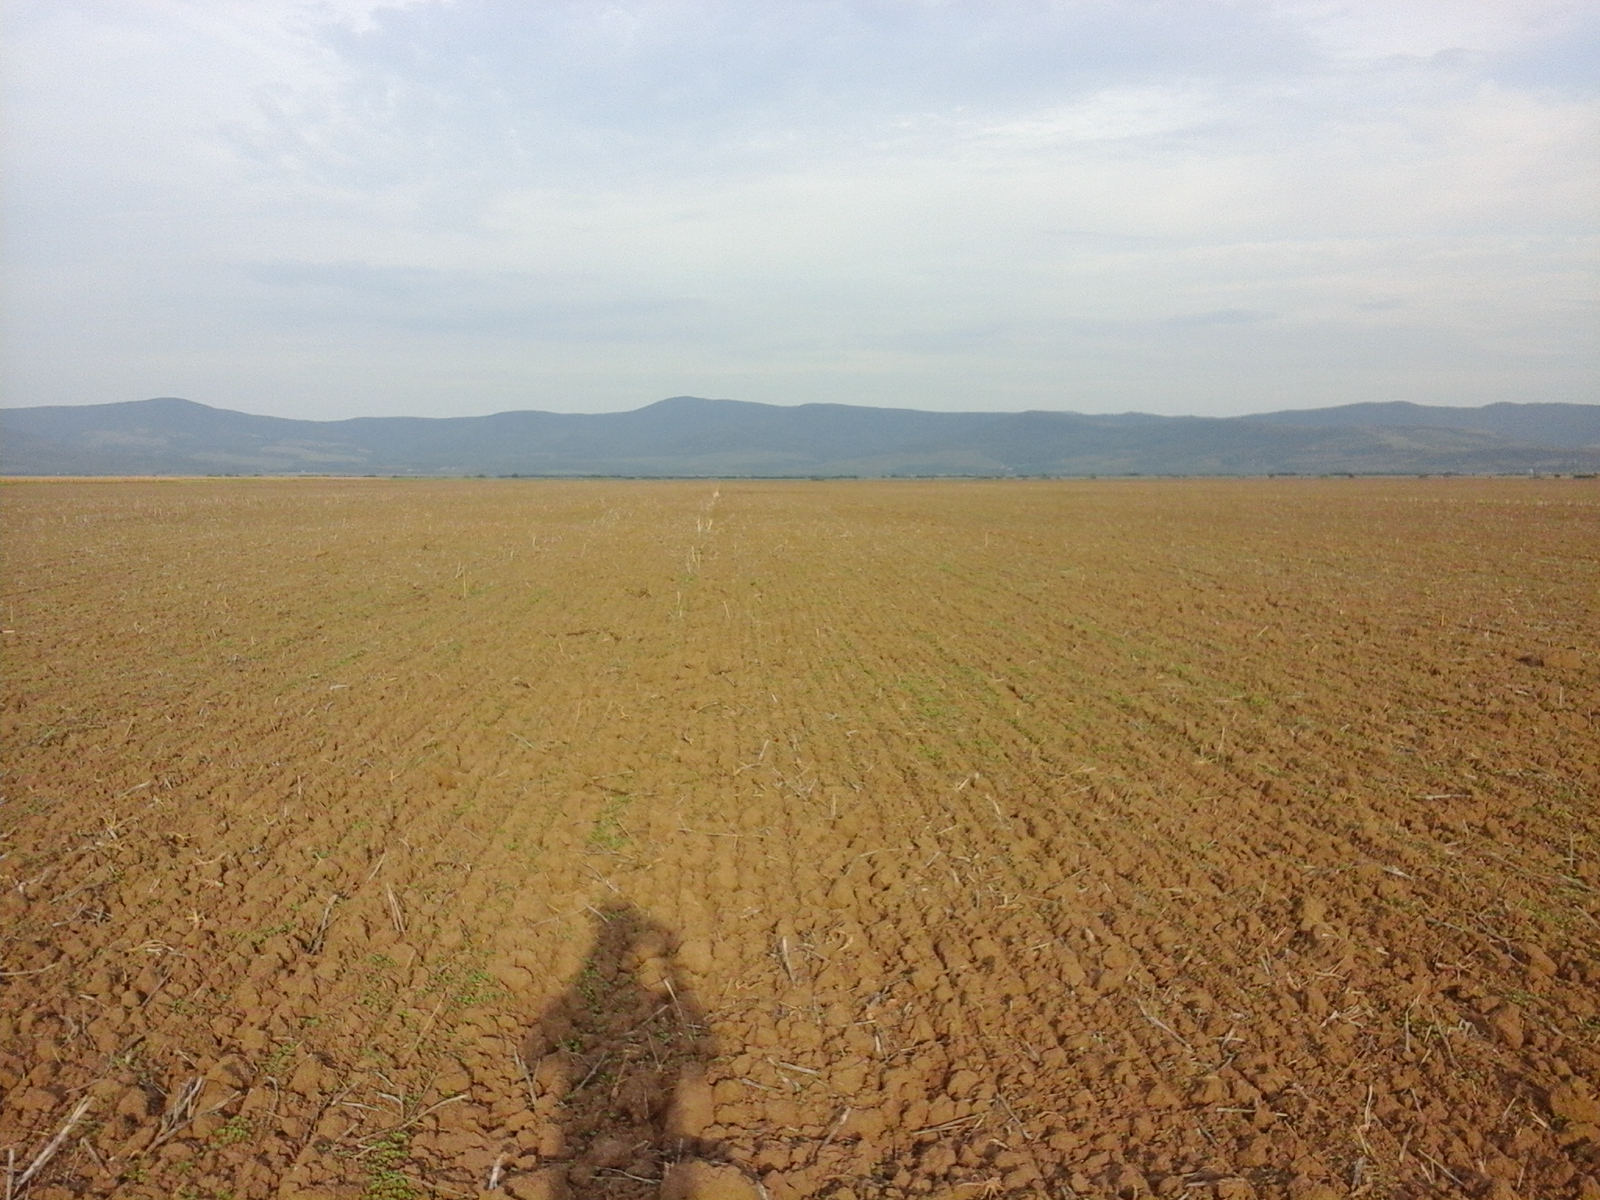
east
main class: Cropland
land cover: Rape and turnip rape
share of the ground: < 10 %
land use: Agriculture (excluding fallow land and kitchen gardens)
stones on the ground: < 10 %
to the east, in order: Rape and turnip rape
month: August
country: RO
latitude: 46.2309
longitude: 21.5644
